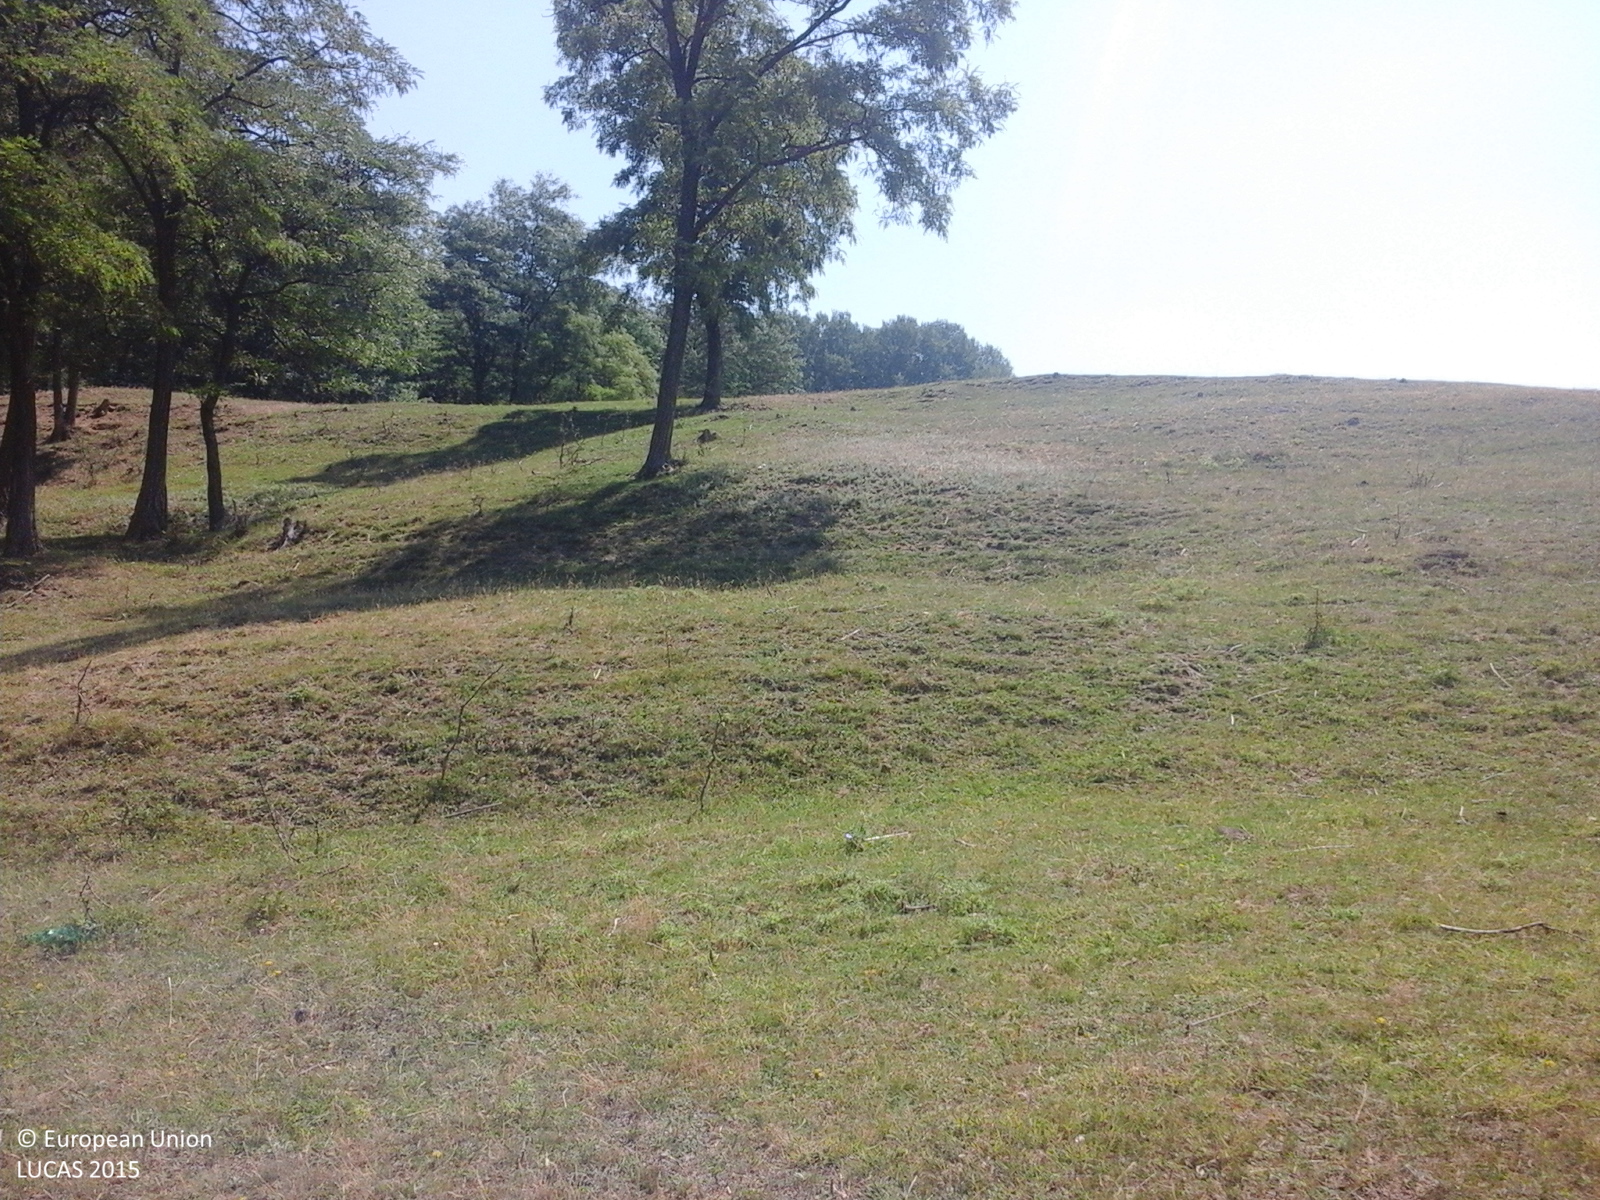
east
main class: Grassland
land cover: Grassland without tree/shrub cover
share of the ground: > 75 %
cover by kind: herbaceous plants 100 %
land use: Agriculture (excluding fallow land and kitchen gardens)
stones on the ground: < 10 %
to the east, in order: Grassland without tree/shrub cover; Broadleaved woodland; Grassland without tree/shrub cover; Broadleaved woodland; Tracks; Common wheat
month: June
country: RO
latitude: 46.8259
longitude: 26.9413
